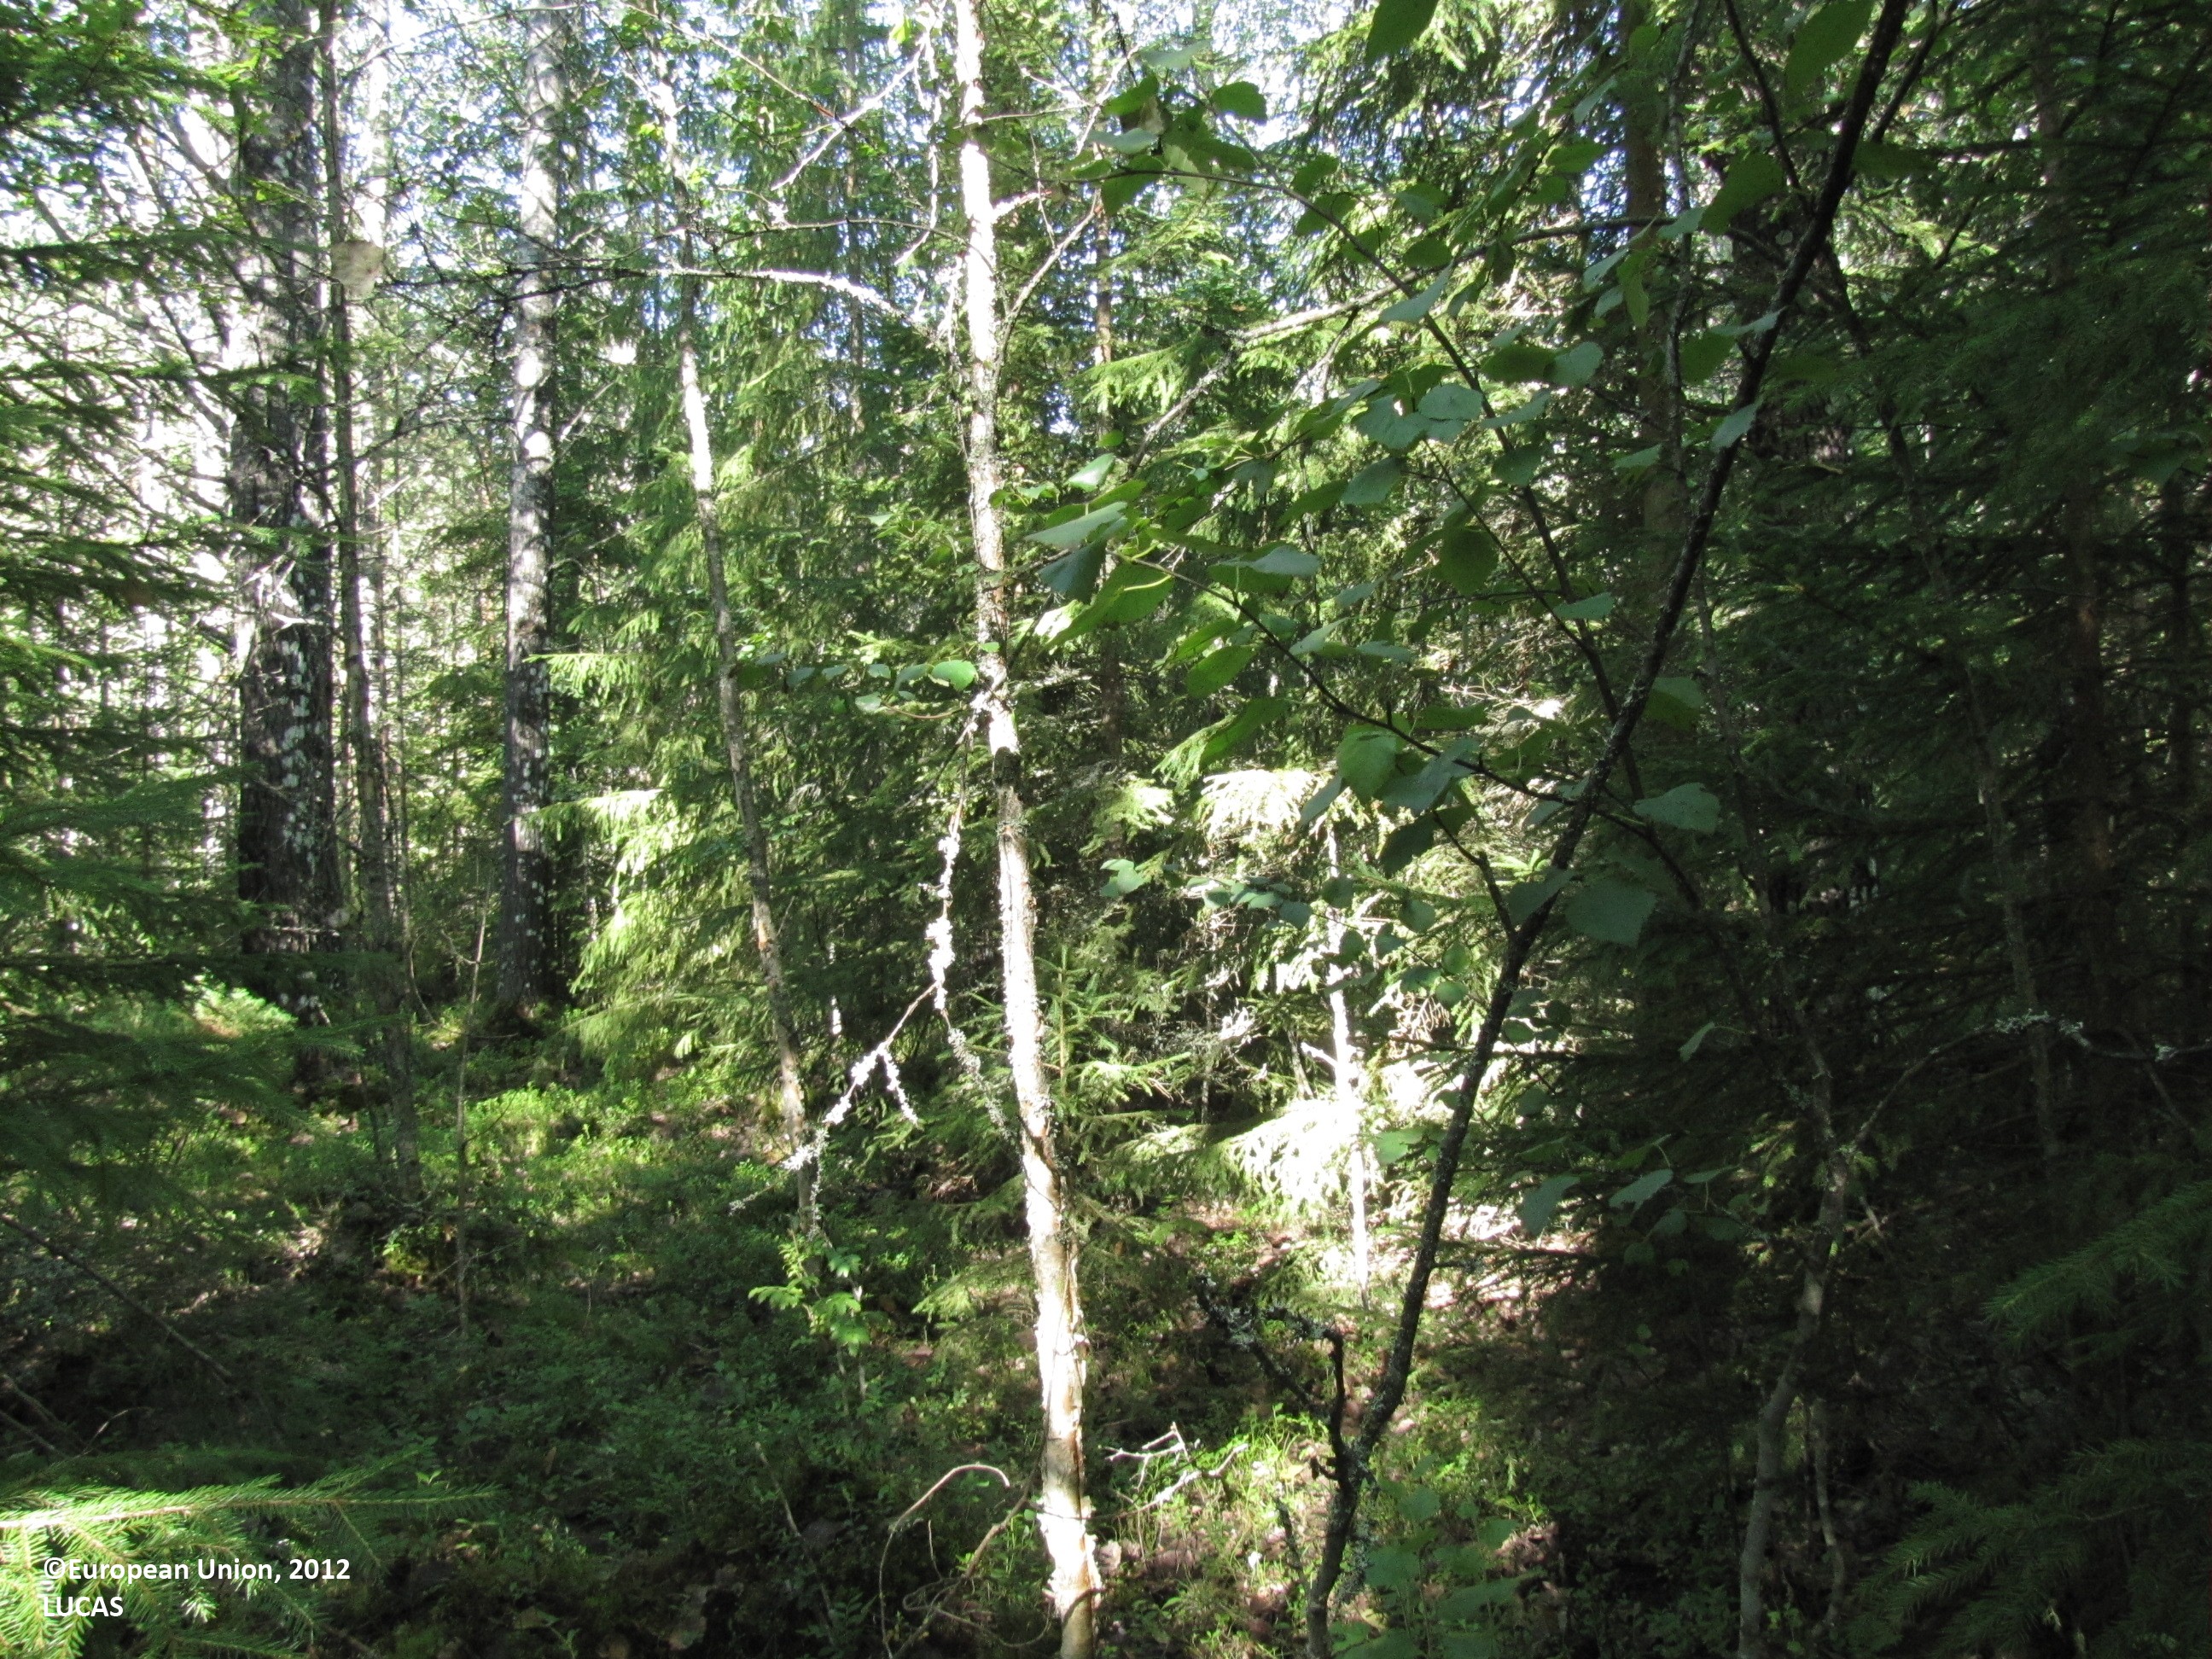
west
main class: Woodland
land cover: Other mixed woodland
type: boreal forest
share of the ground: > 75 %
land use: Forestry
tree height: > 5 m
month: July
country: FI
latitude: 62.0910
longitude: 23.1099
